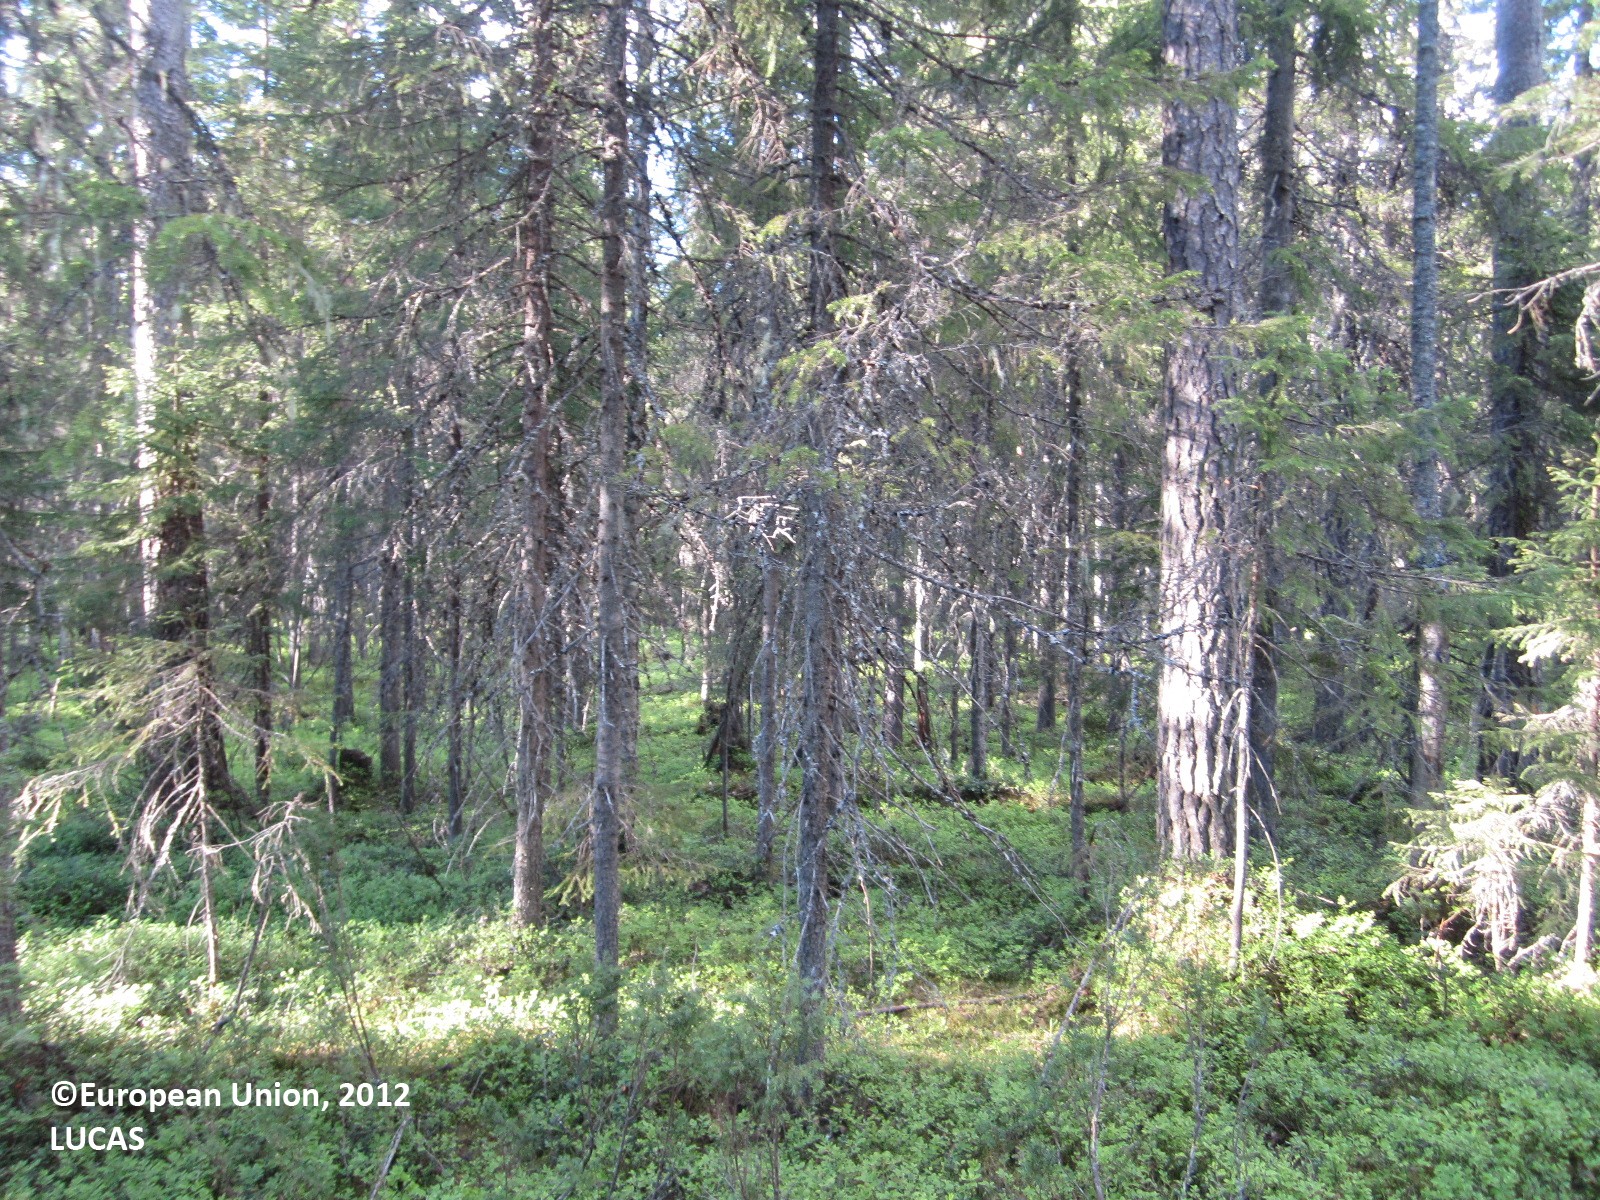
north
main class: Woodland
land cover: Spruce dominated coniferous woodland
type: boreal forest
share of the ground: > 75 %
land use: Forestry
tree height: > 5 m
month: June
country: FI
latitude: 64.7036
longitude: 28.7444
